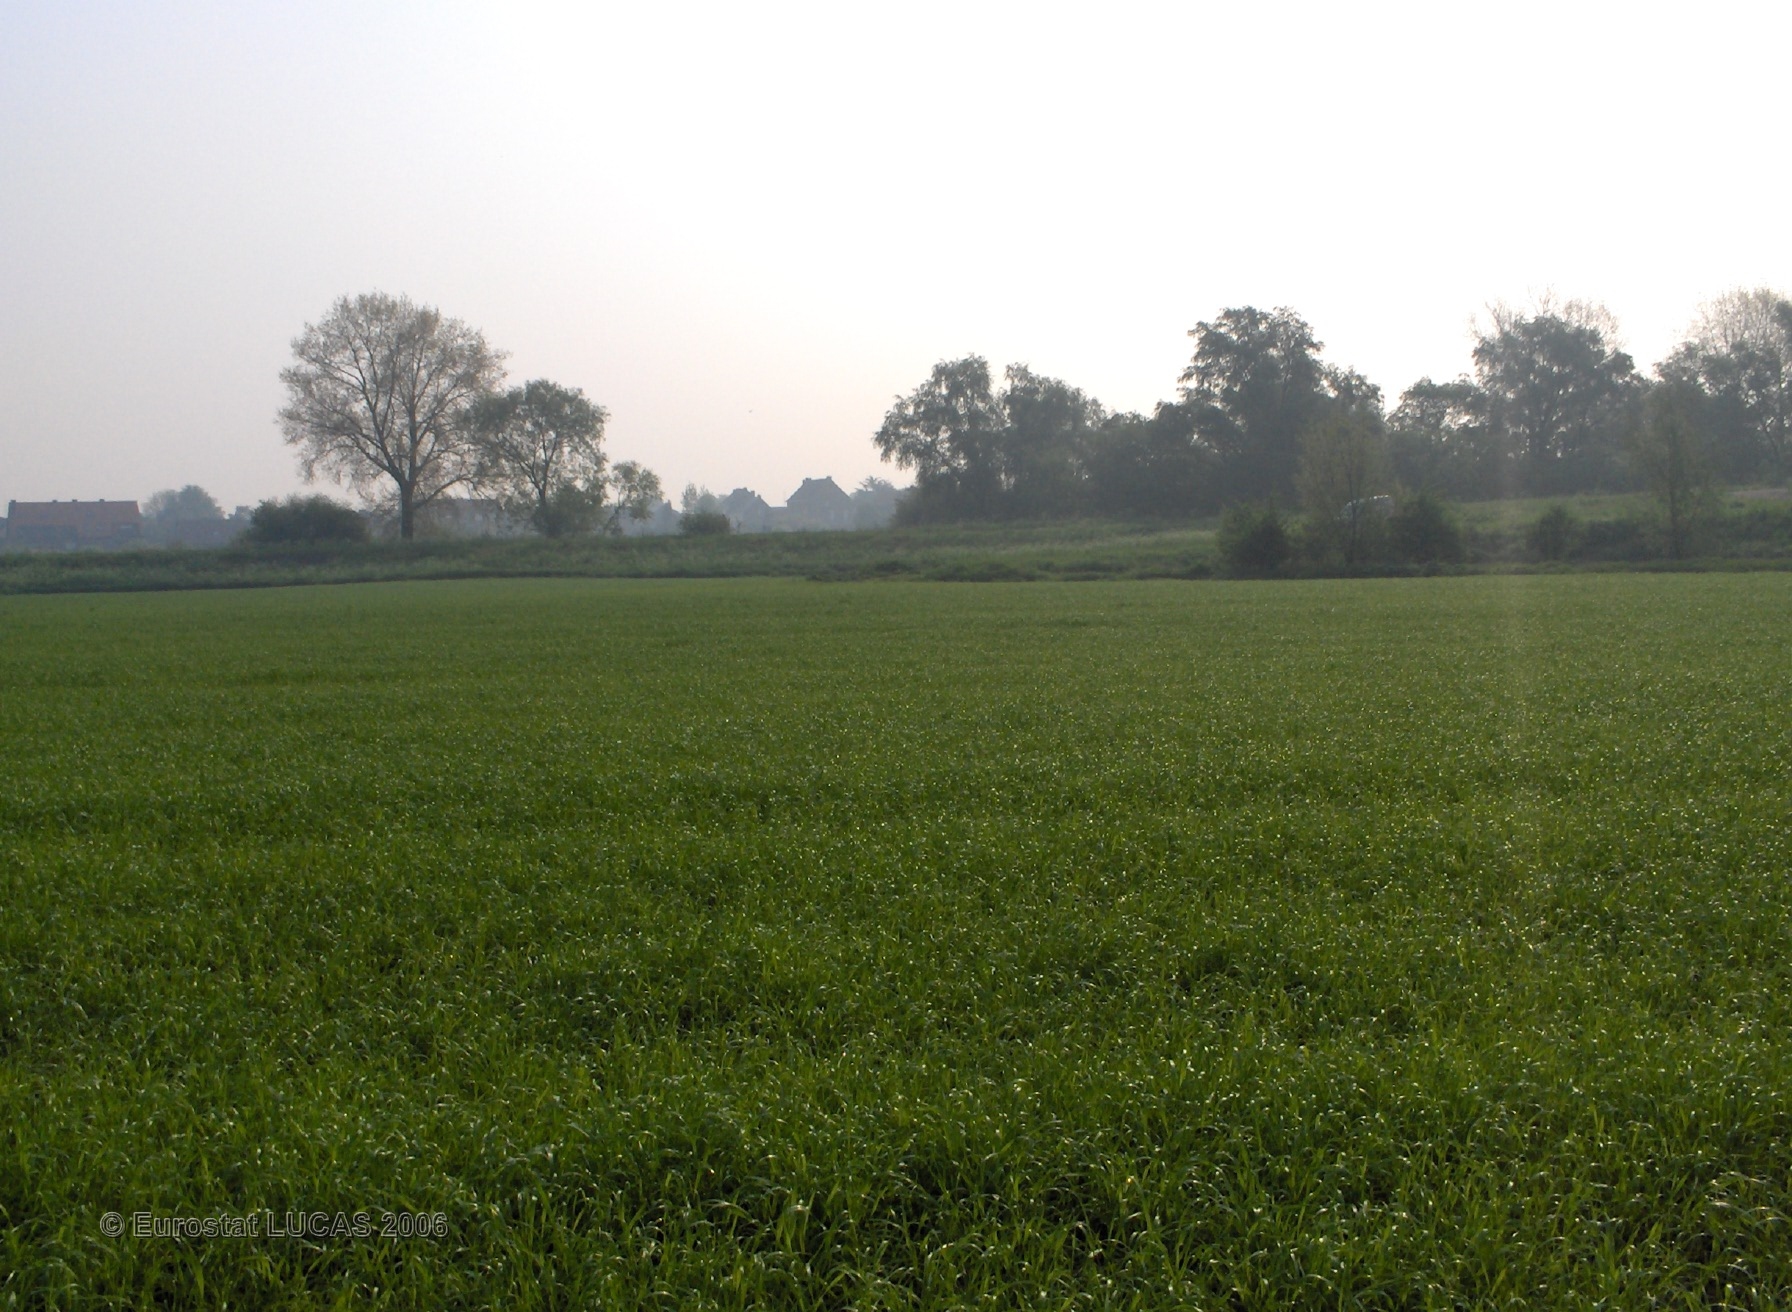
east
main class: Cropland
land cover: Triticale
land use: Agriculture (excluding fallow land and kitchen gardens)
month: May
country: BE
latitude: 51.0747
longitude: 4.4149
